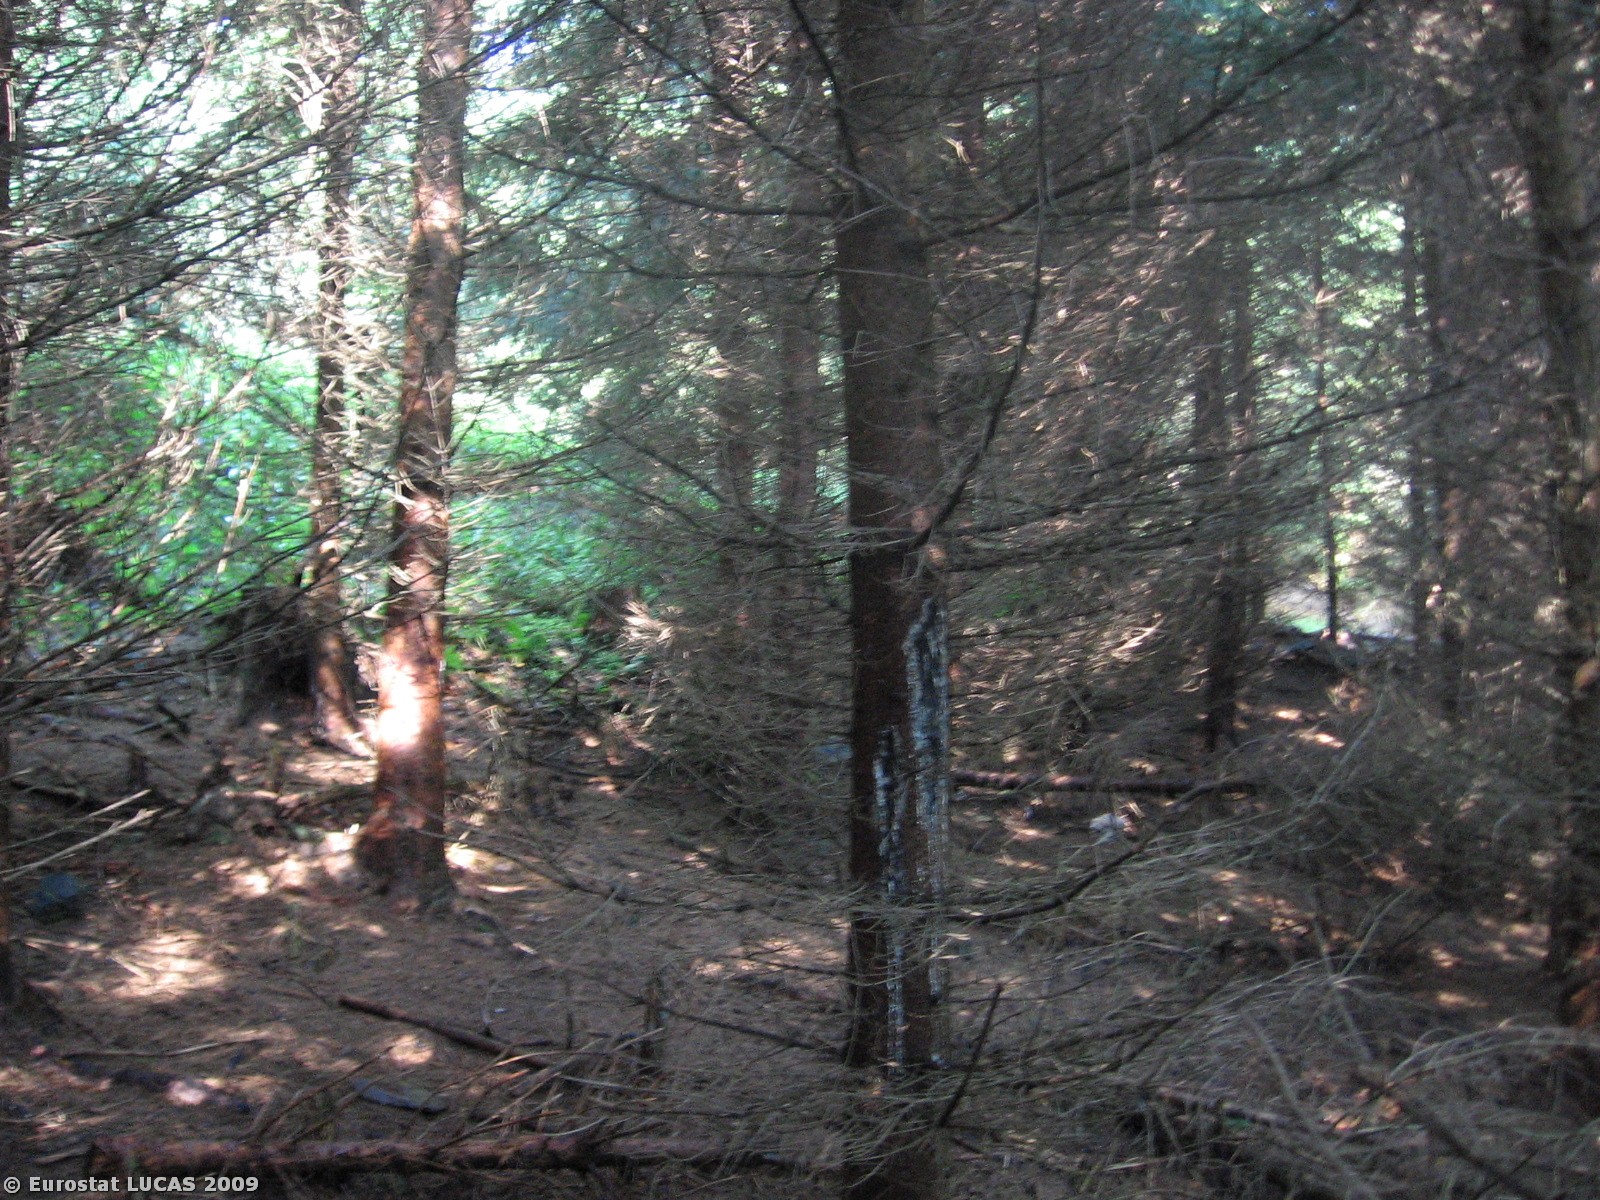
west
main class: Woodland
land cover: Coniferous woodland
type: hemiboreal forest and nemoral coniferous forest and mixed broadleaved-coniferous forest
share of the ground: > 75 %
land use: Forestry
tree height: > 5 m
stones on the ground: < 10 %
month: July
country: CZ
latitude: 49.2582
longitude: 13.1738
